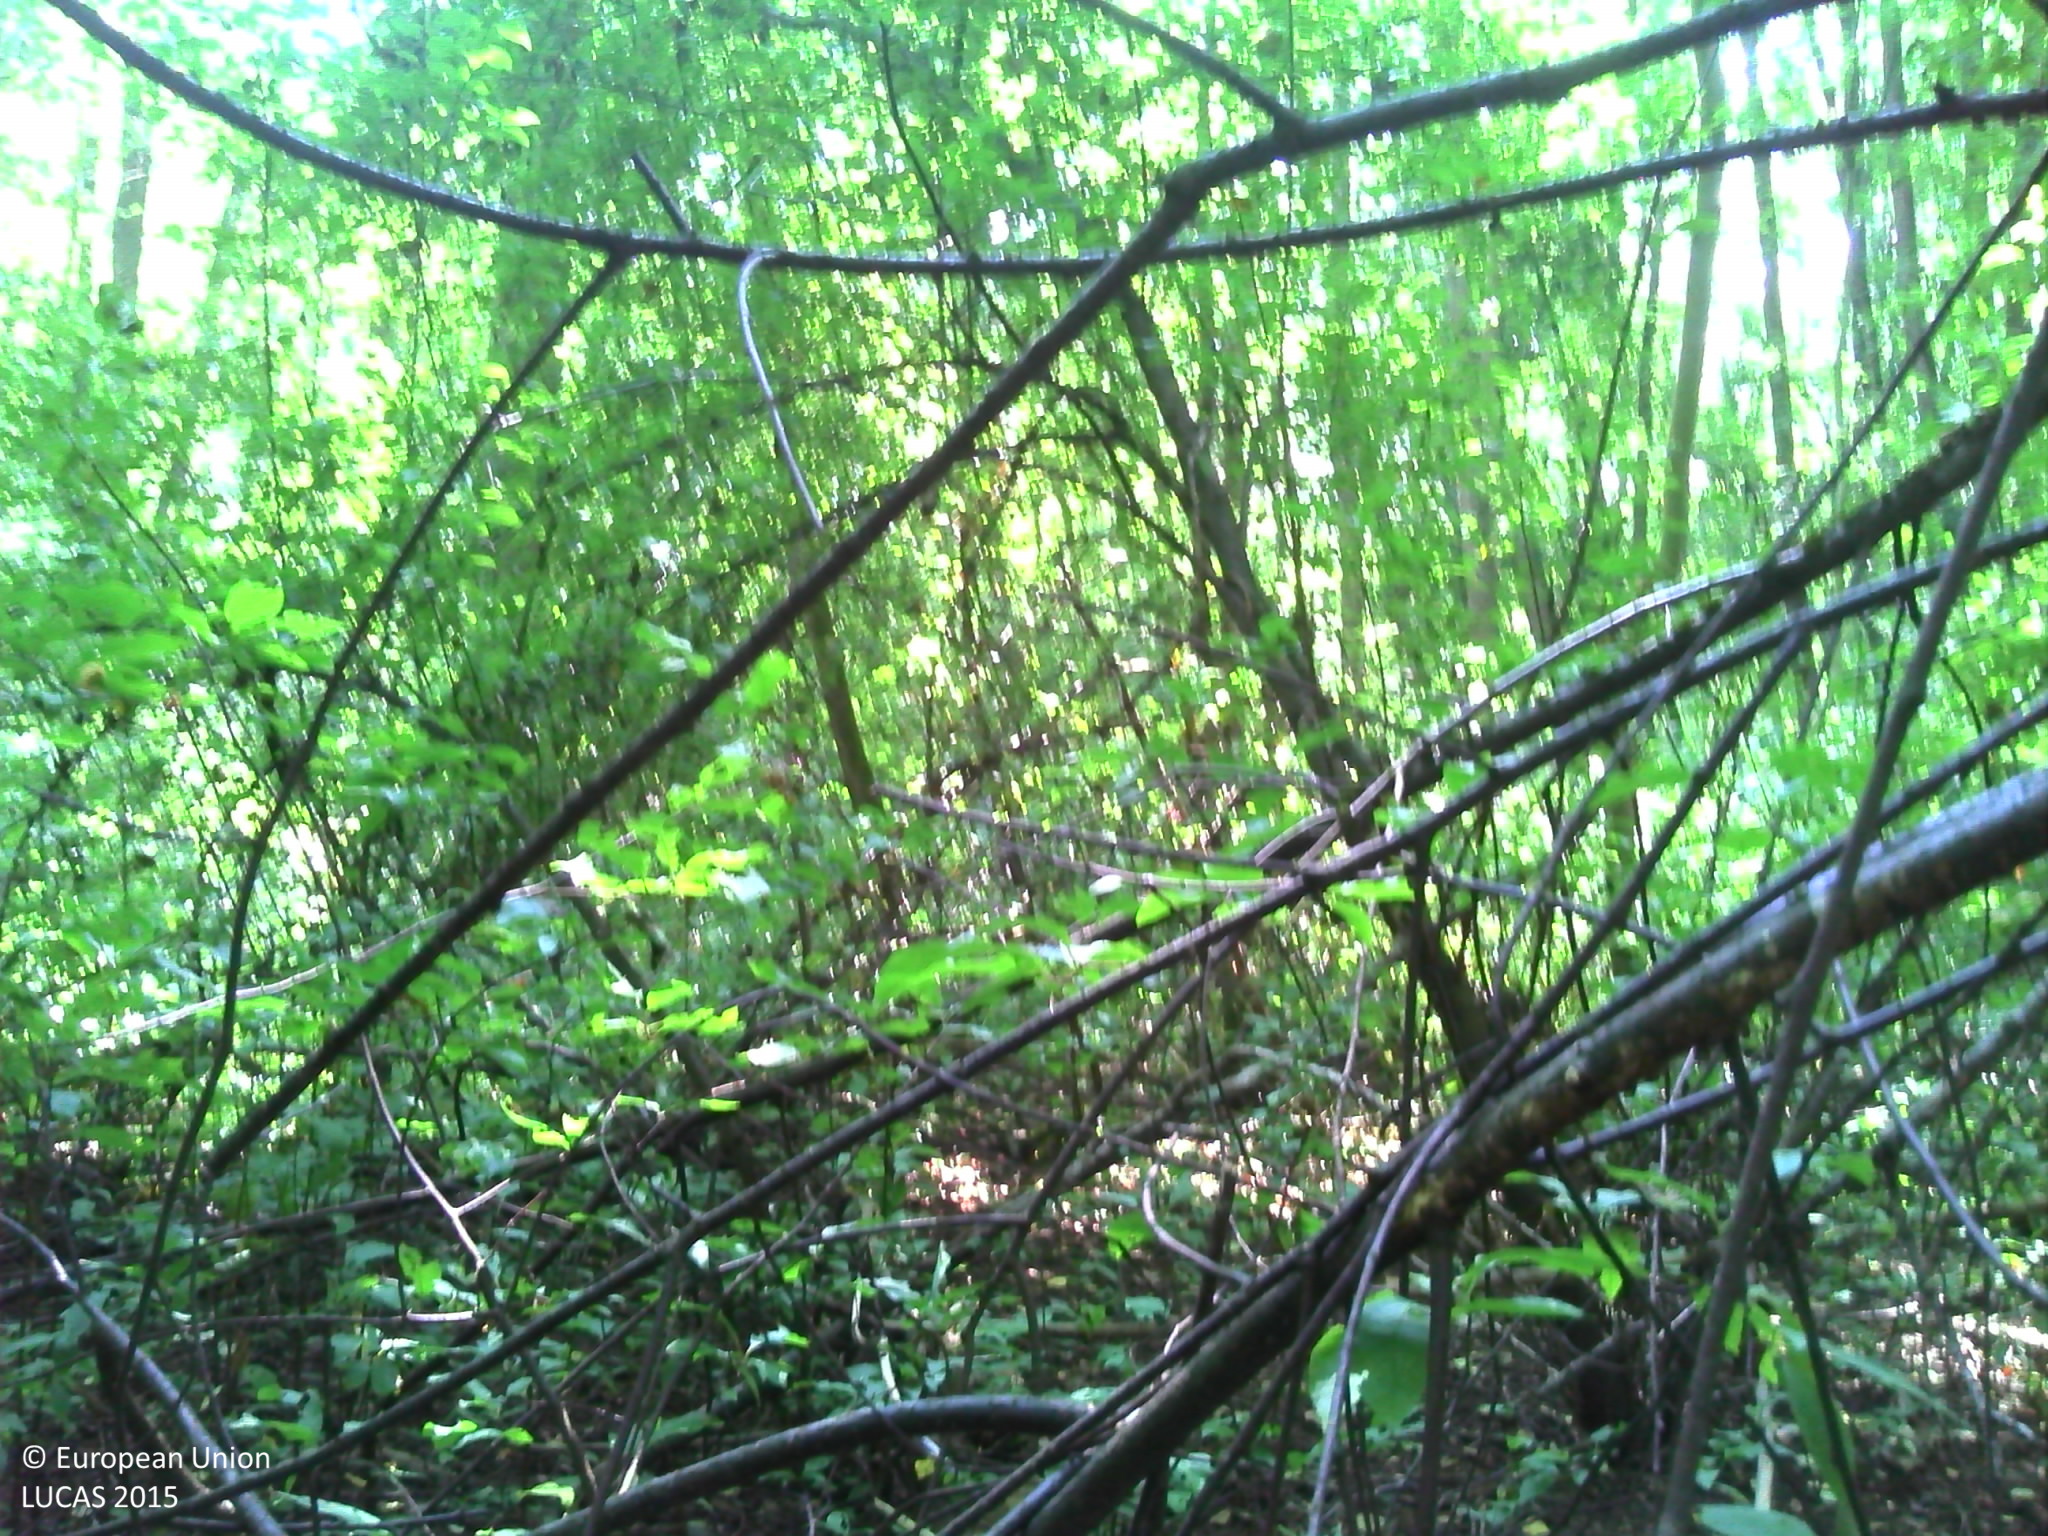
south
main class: Woodland
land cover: Broadleaved woodland
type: mesophytic deciduous forest
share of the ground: > 75 %
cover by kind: broadleaved forest trees 95 %, herbaceous plants 5 %
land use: Forestry
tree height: > 5 m
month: August
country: FR
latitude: 48.6514
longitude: 7.7882
